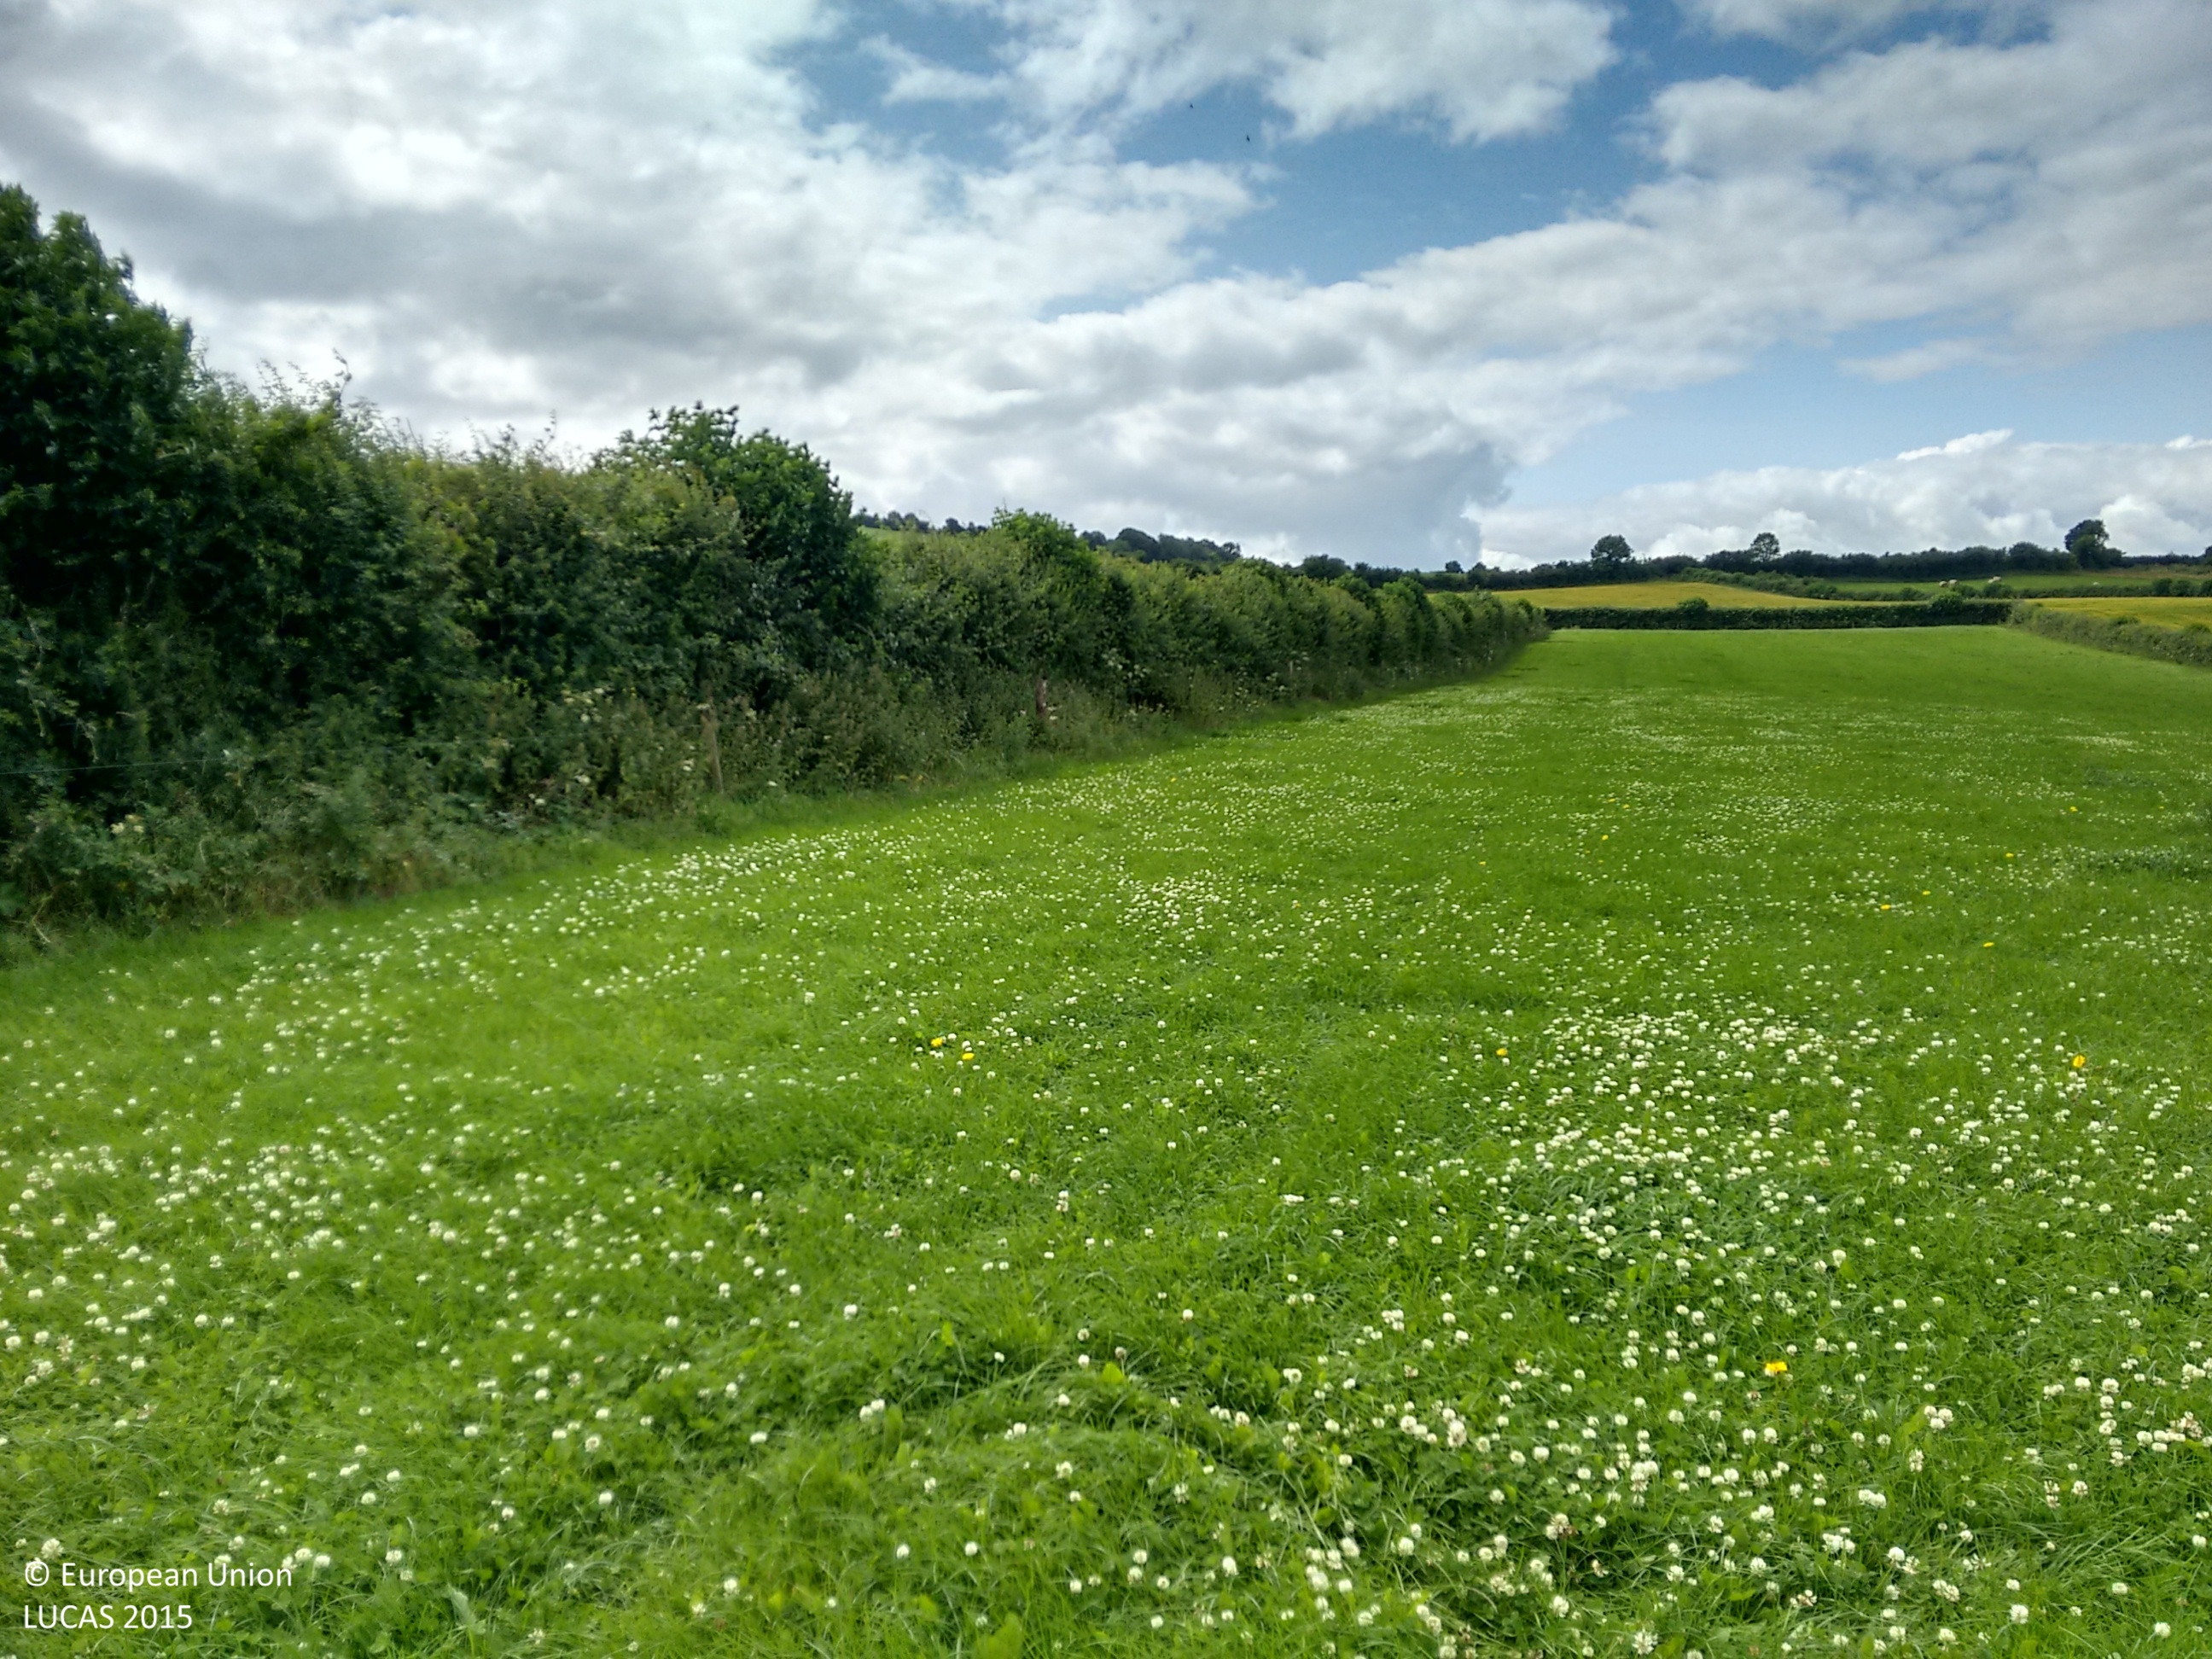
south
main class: Grassland
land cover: Grassland without tree/shrub cover
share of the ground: > 75 %
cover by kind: herbaceous plants 100 %
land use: Agriculture (excluding fallow land and kitchen gardens)
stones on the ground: < 10 %
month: July
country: IE
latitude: 52.7734
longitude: -7.5171
